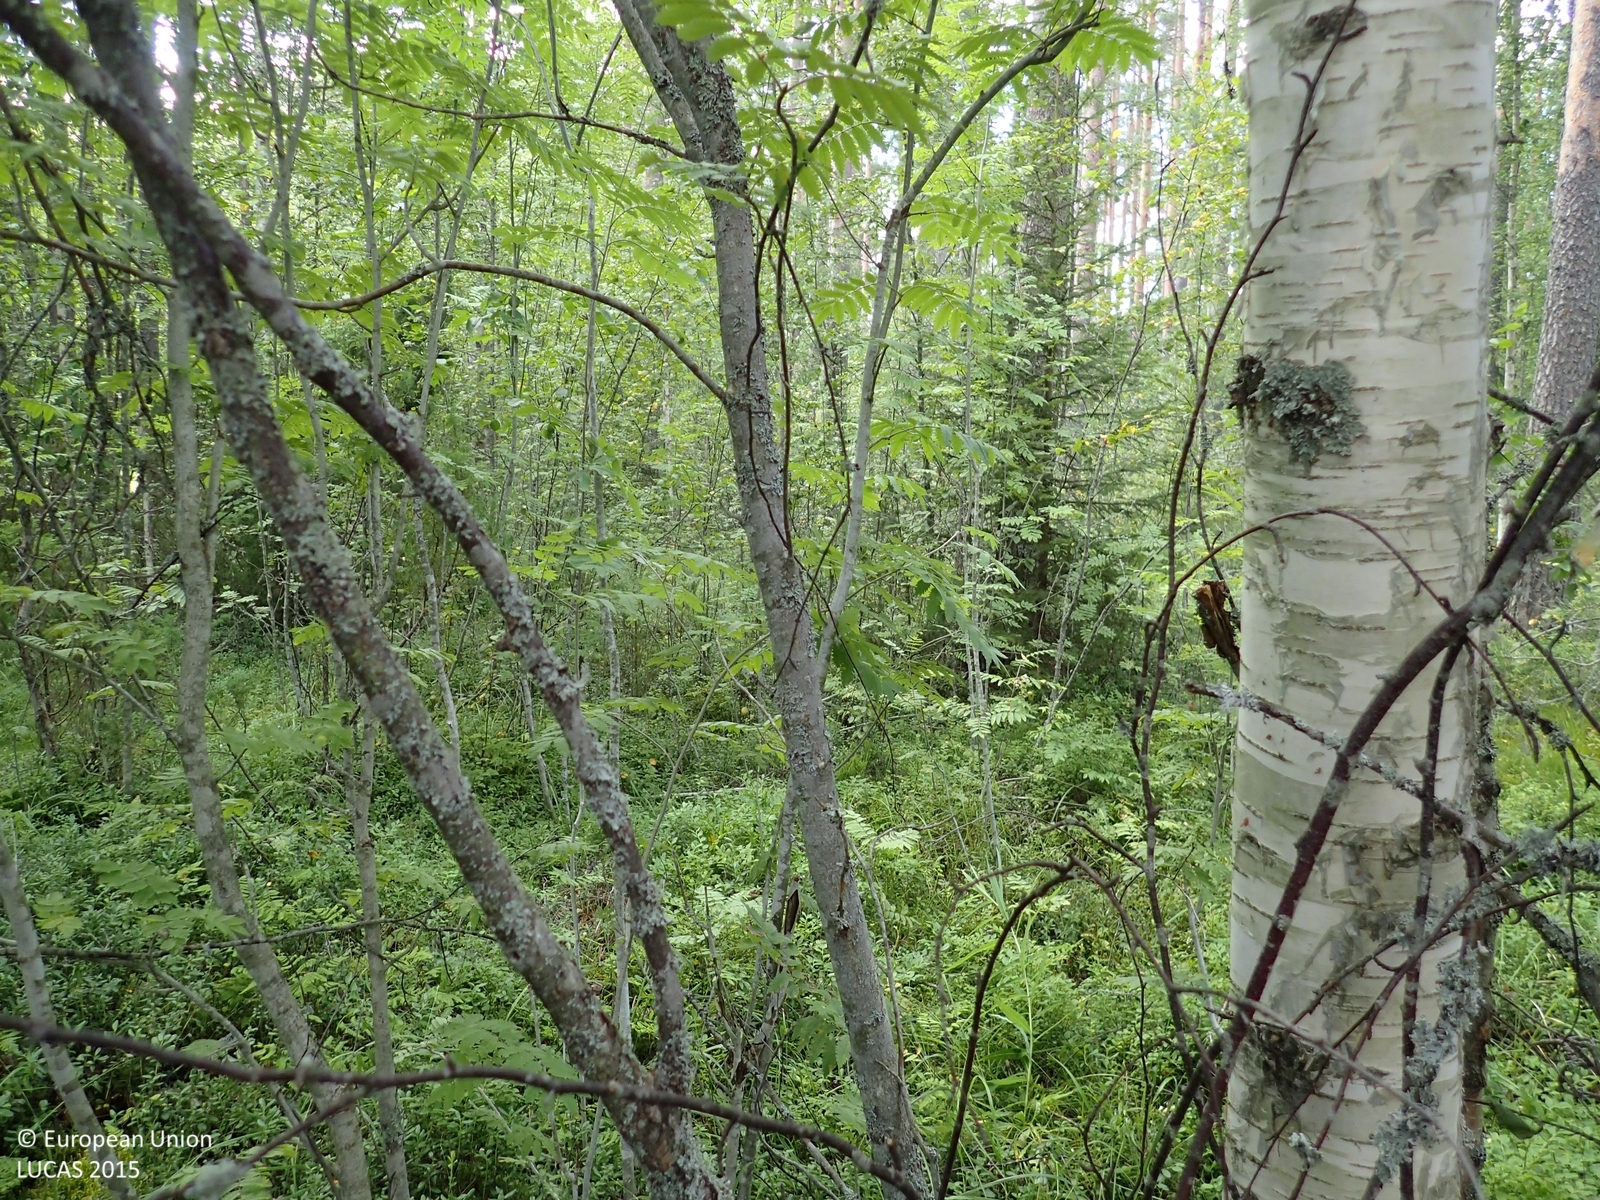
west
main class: Woodland
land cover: Pine dominated mixed woodland
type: boreal forest
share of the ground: > 75 %
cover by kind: coniferous forest trees 60 %, broadleaved forest trees 20 %, shrubs 15 %, herbaceous plants 5 %
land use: Forestry
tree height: > 5 m
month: August
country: FI
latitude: 62.6719
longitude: 21.8587
